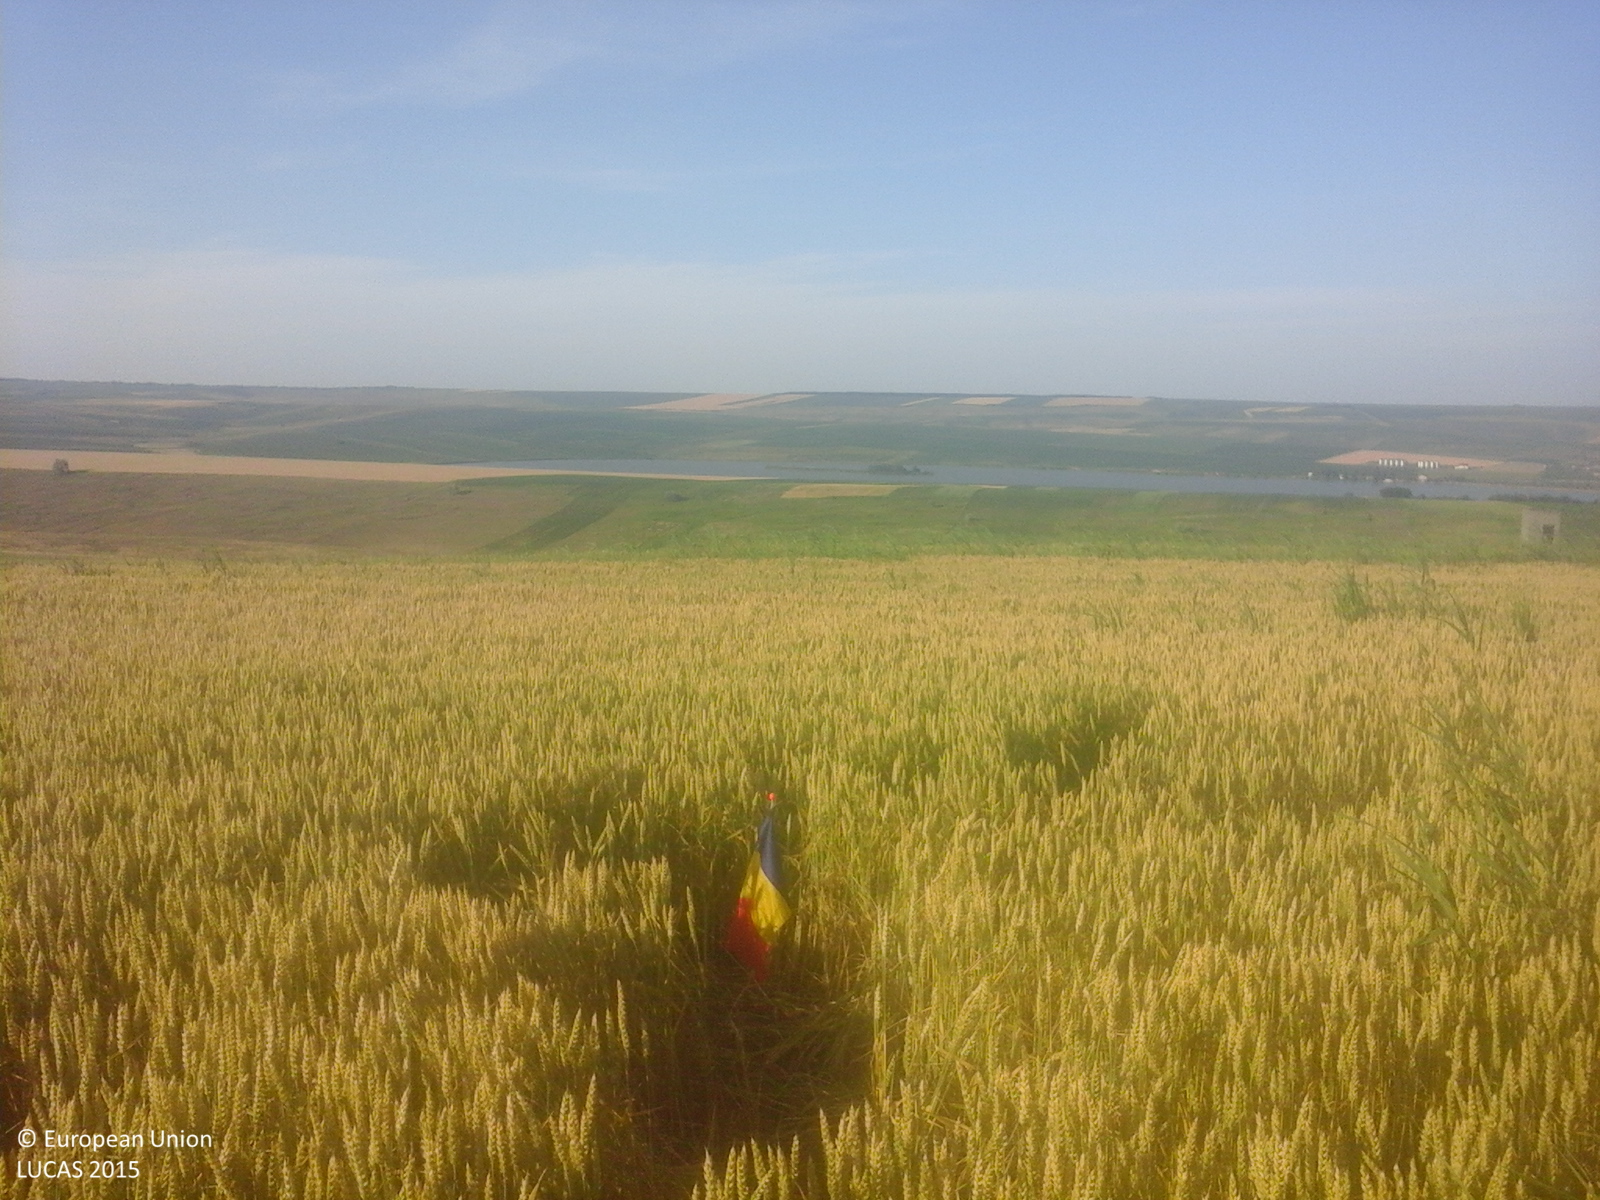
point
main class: Cropland
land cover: Common wheat
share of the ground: > 75 %
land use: Agriculture (excluding fallow land and kitchen gardens)
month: June
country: RO
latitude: 47.9094
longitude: 26.9488
